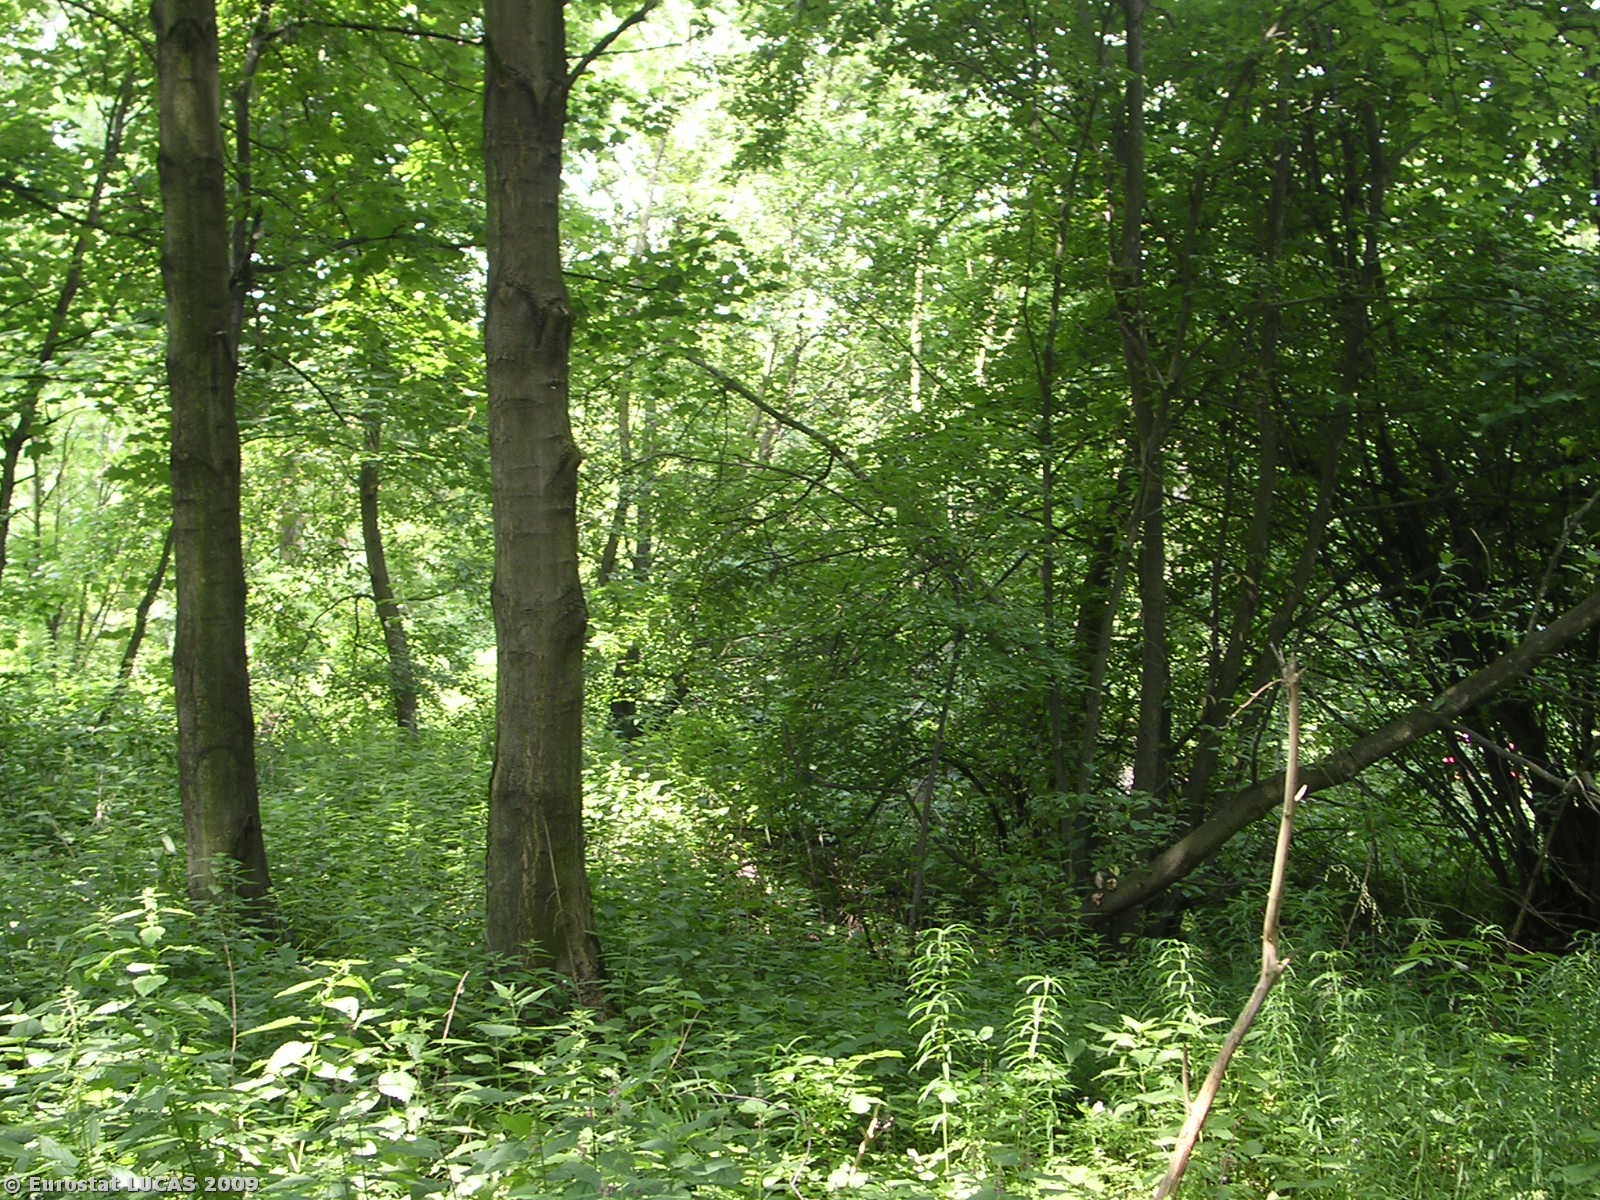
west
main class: Woodland
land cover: Broadleaved woodland
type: mesophytic deciduous forest
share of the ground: > 75 %
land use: Forestry
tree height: > 5 m
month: June
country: CZ
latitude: 50.6798
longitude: 14.2896
